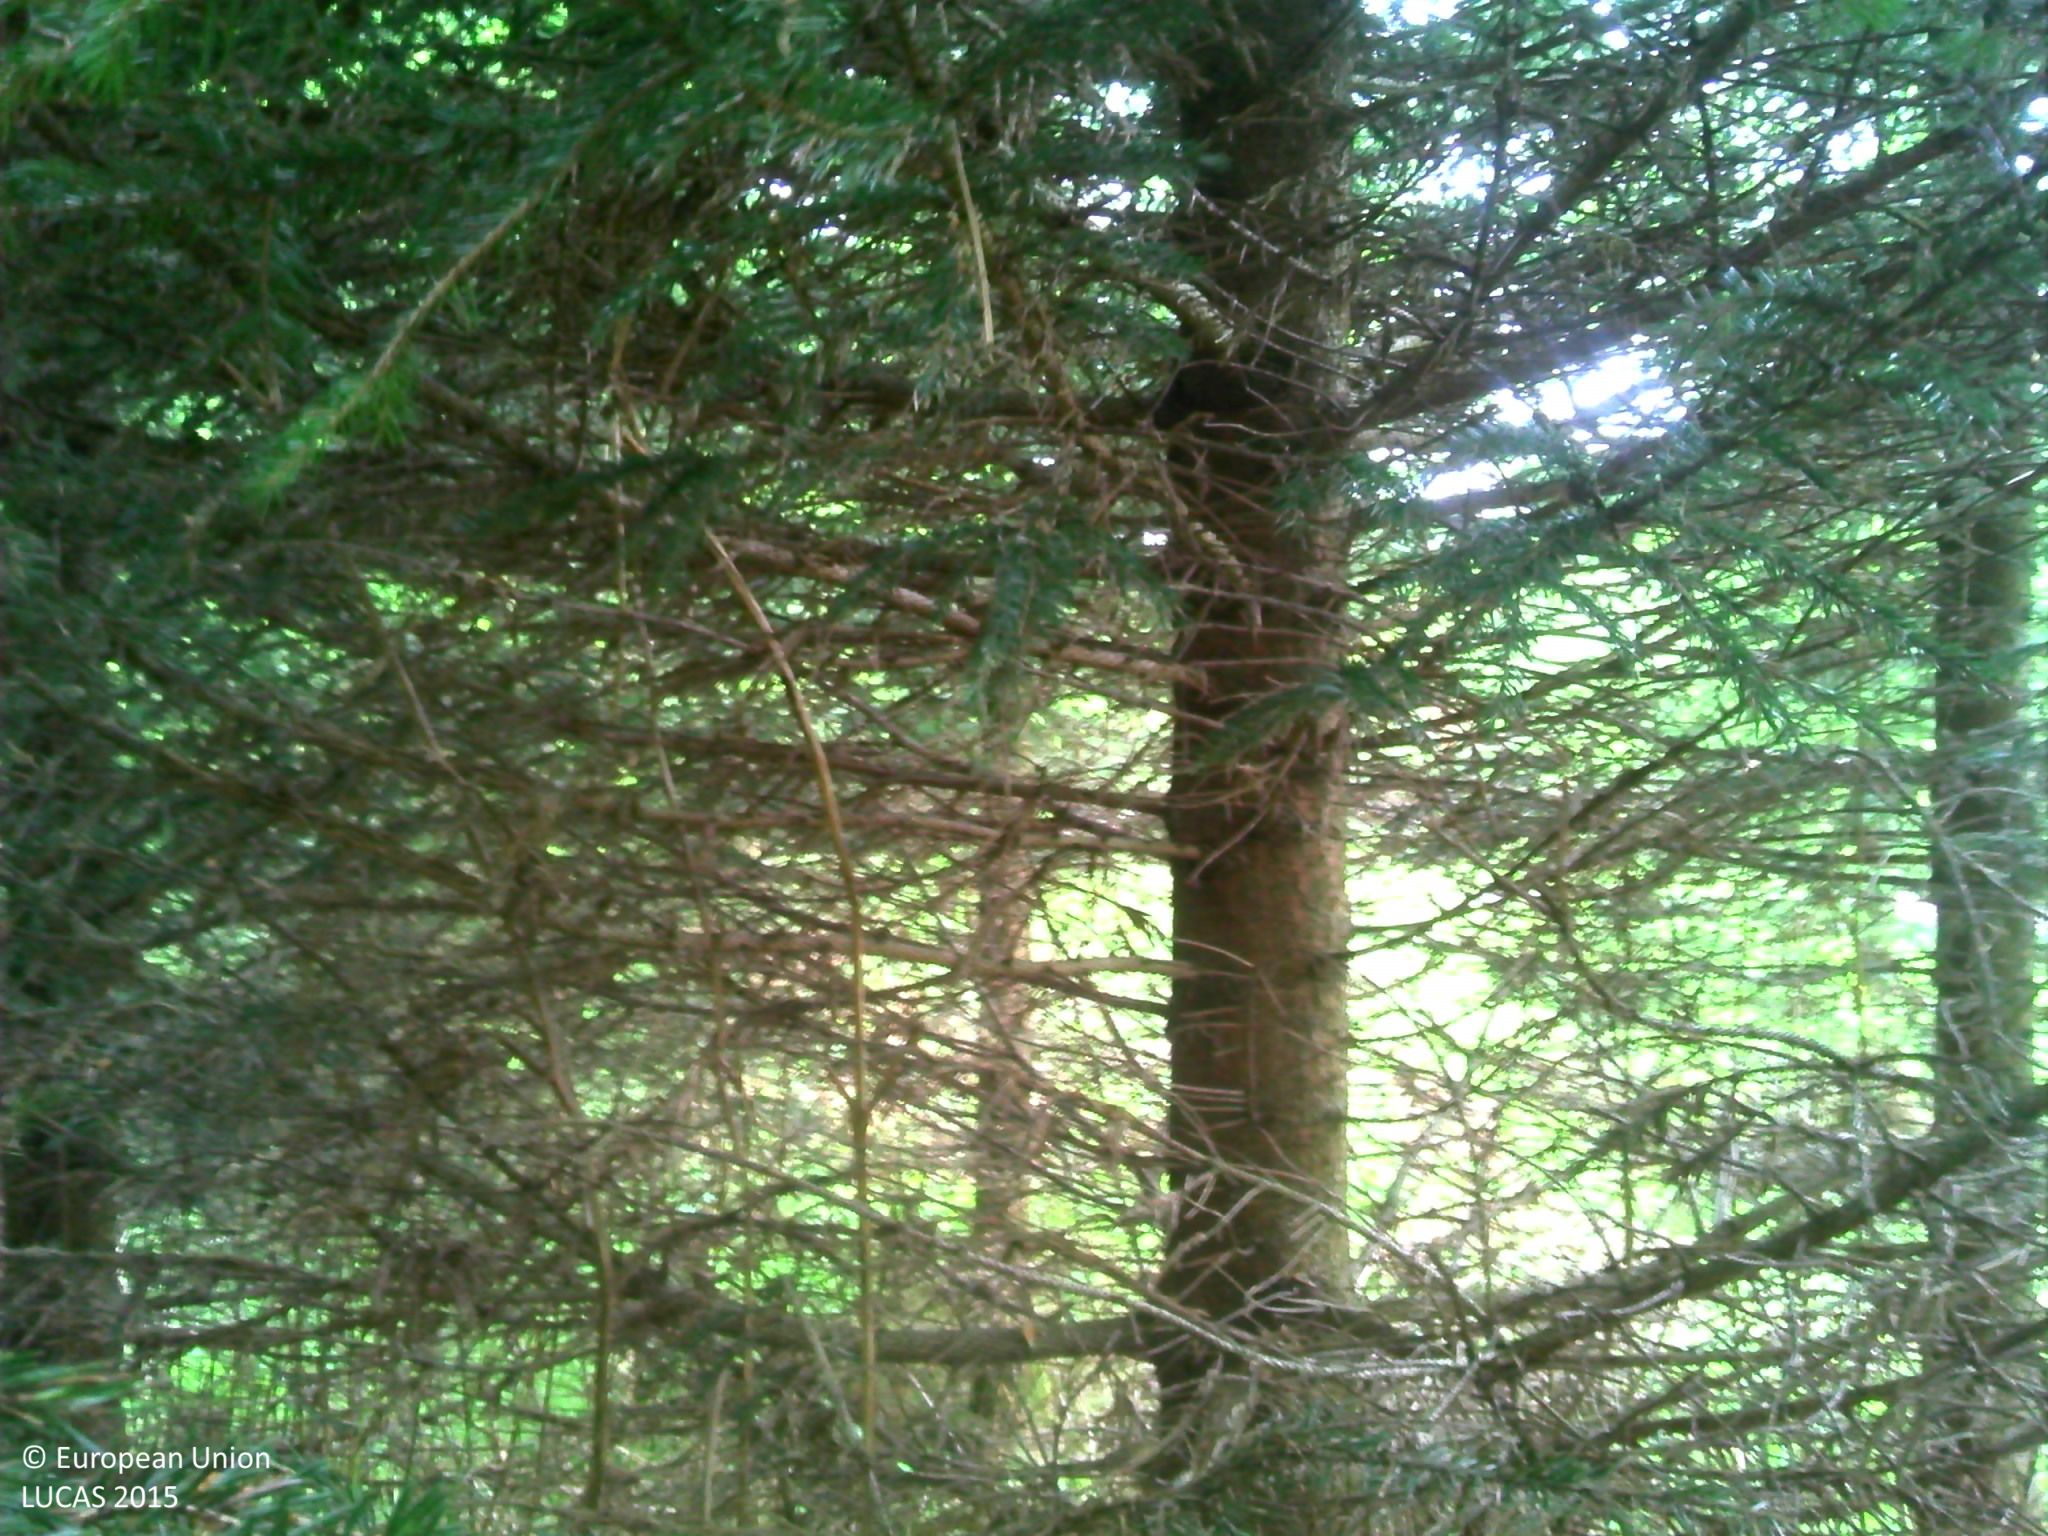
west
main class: Woodland
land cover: Spruce dominated coniferous woodland
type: exotic forest
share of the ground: > 75 %
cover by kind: coniferous forest trees 85 %, herbaceous plants 15 %
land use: Forestry
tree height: > 5 m
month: June
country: BE
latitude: 49.9420
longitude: 4.8552
